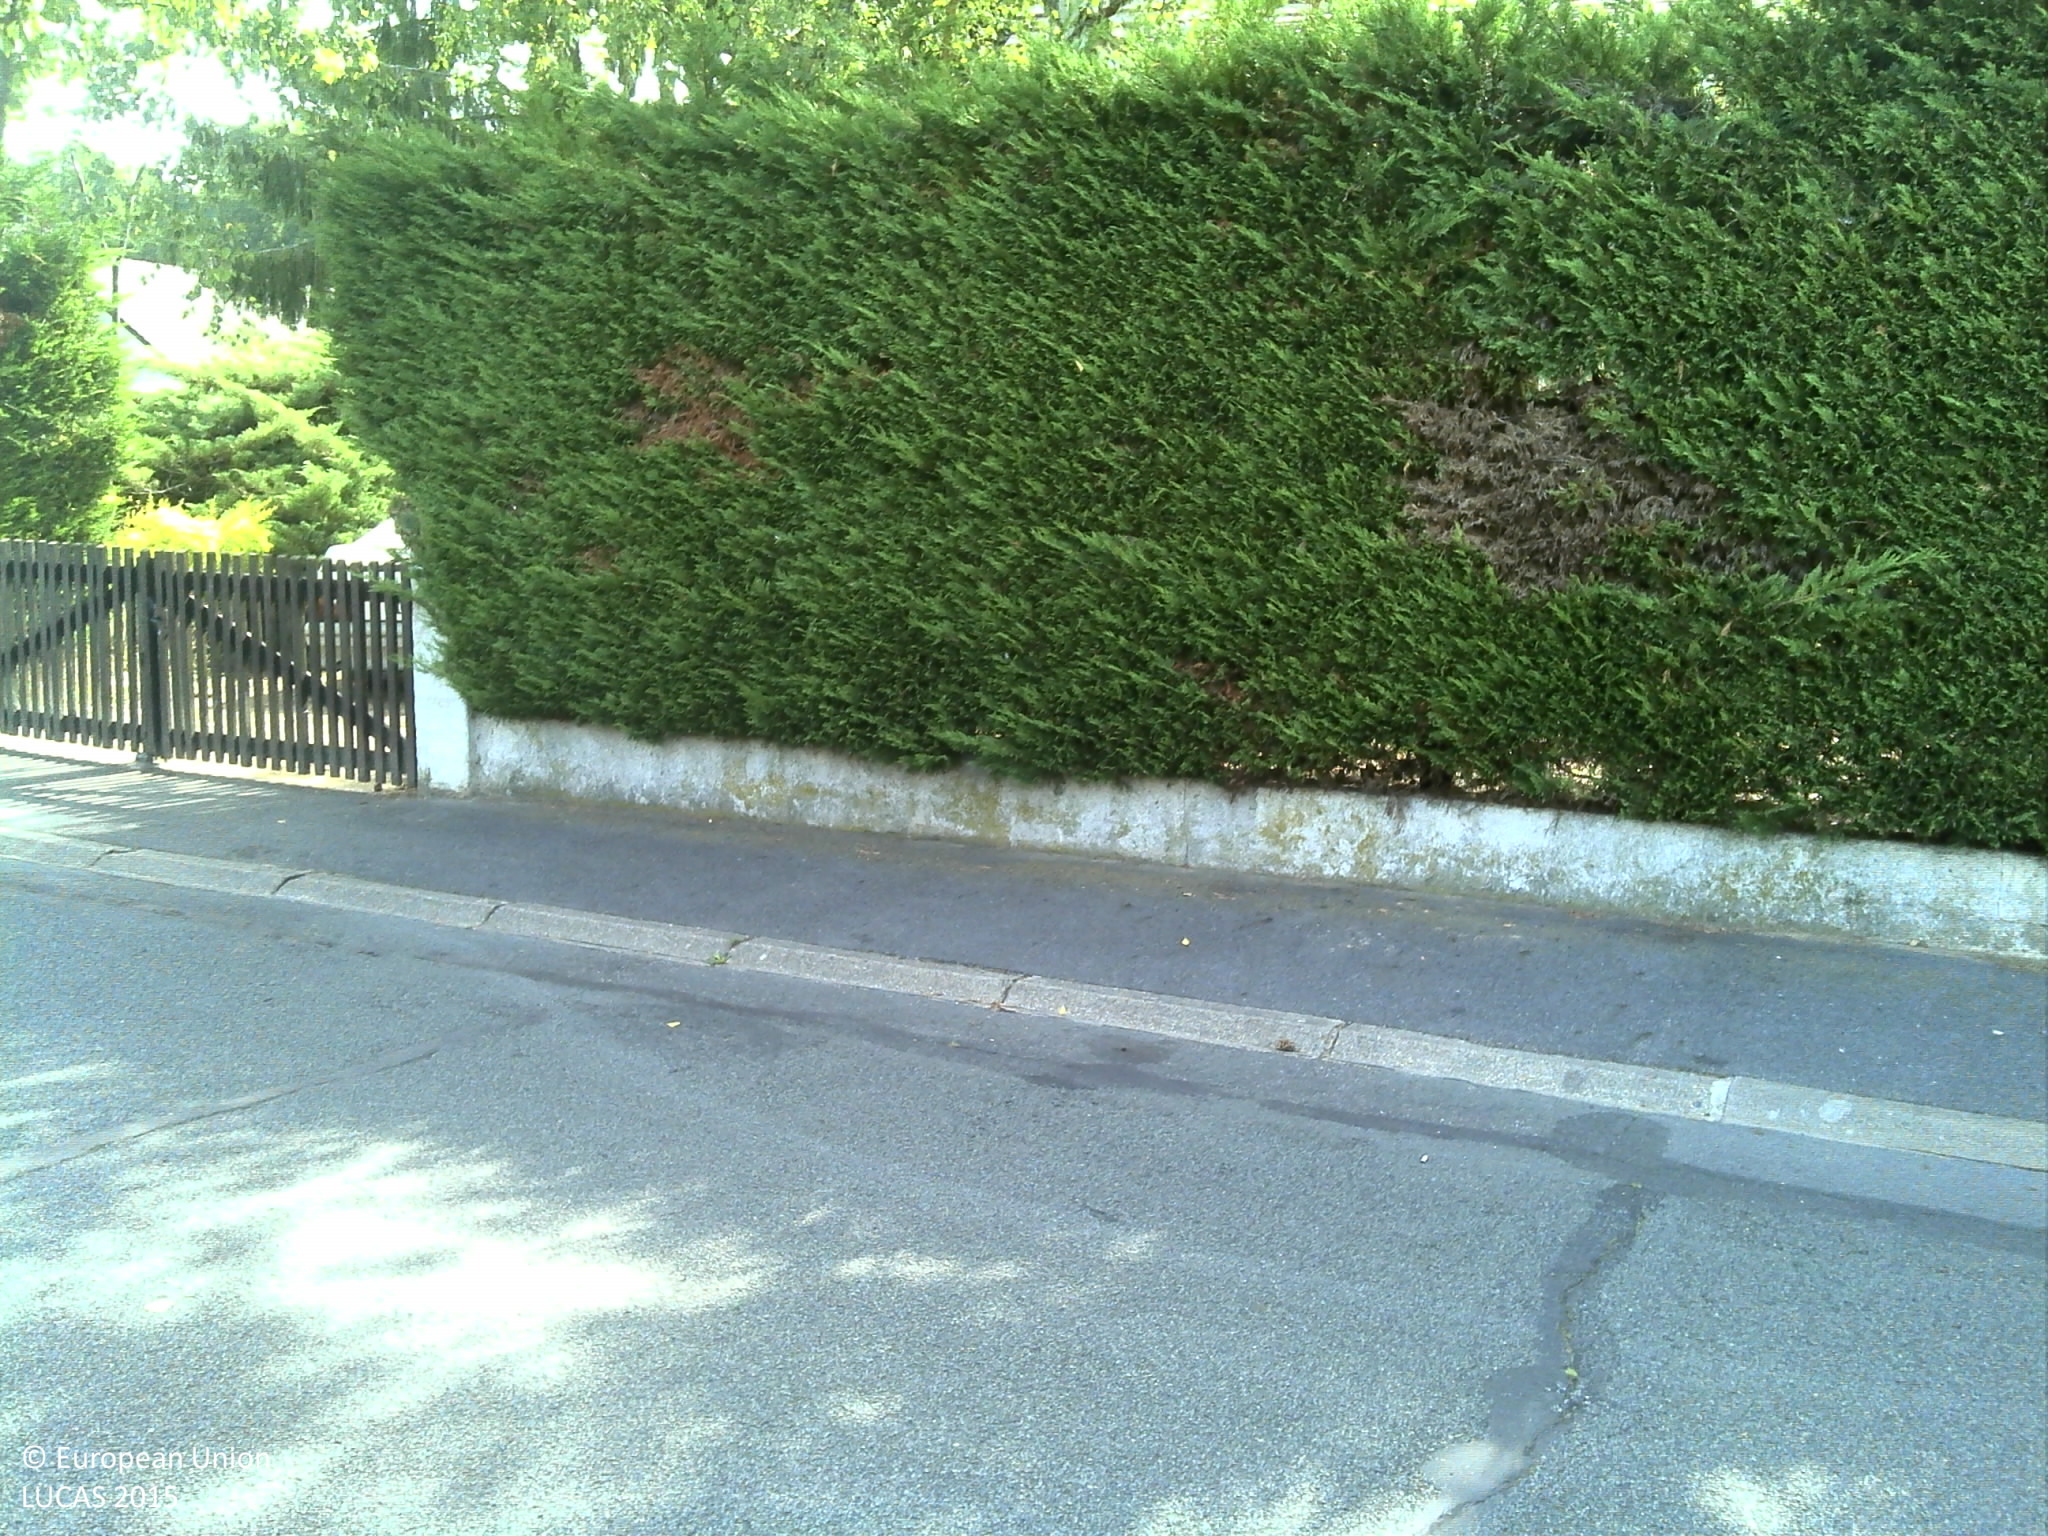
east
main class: Grassland
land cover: Grassland with sparse tree/shrub cover
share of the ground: > 75 %
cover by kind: herbaceous plants 95 %, broadleaved forest trees 5 %
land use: Residential
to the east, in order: Artificial constructions in urban areas; Broadleaved woodland; Fences; Broadleaved woodland
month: July
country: FR
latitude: 48.5796
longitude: 1.9479
